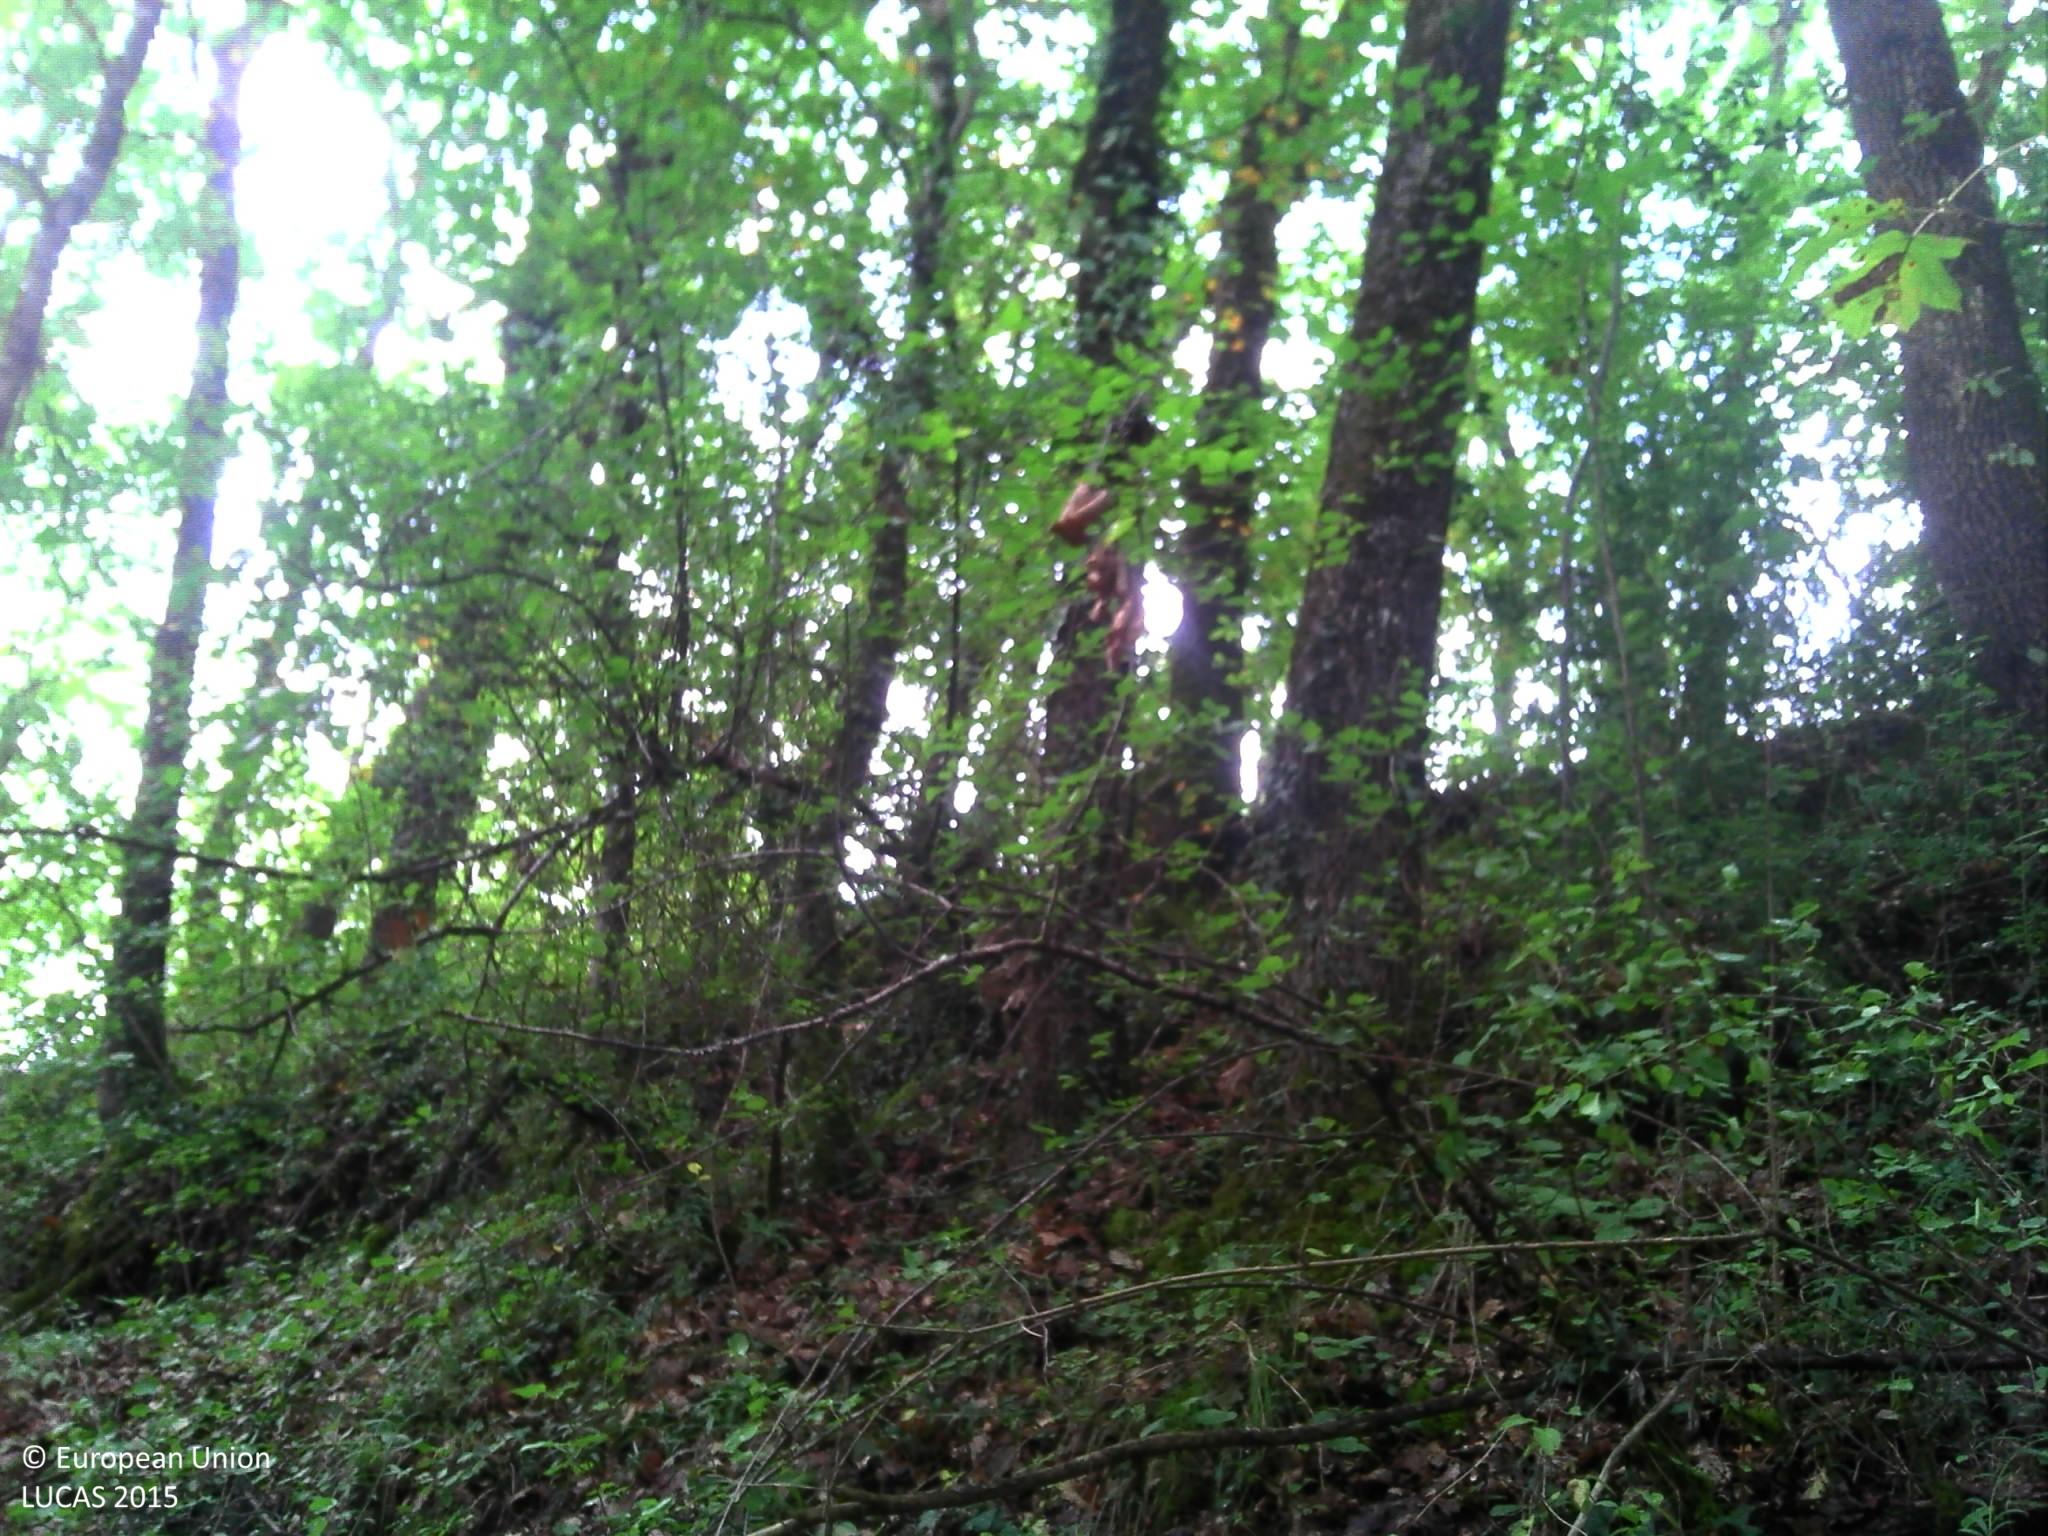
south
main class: Woodland
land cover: Broadleaved woodland
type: mesophytic deciduous forest
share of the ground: > 75 %
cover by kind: broadleaved forest trees 80 %, shrubs 10 %, herbaceous plants 10 %
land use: Forestry
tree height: > 5 m
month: August
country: FR
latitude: 44.2581
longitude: 1.3184
